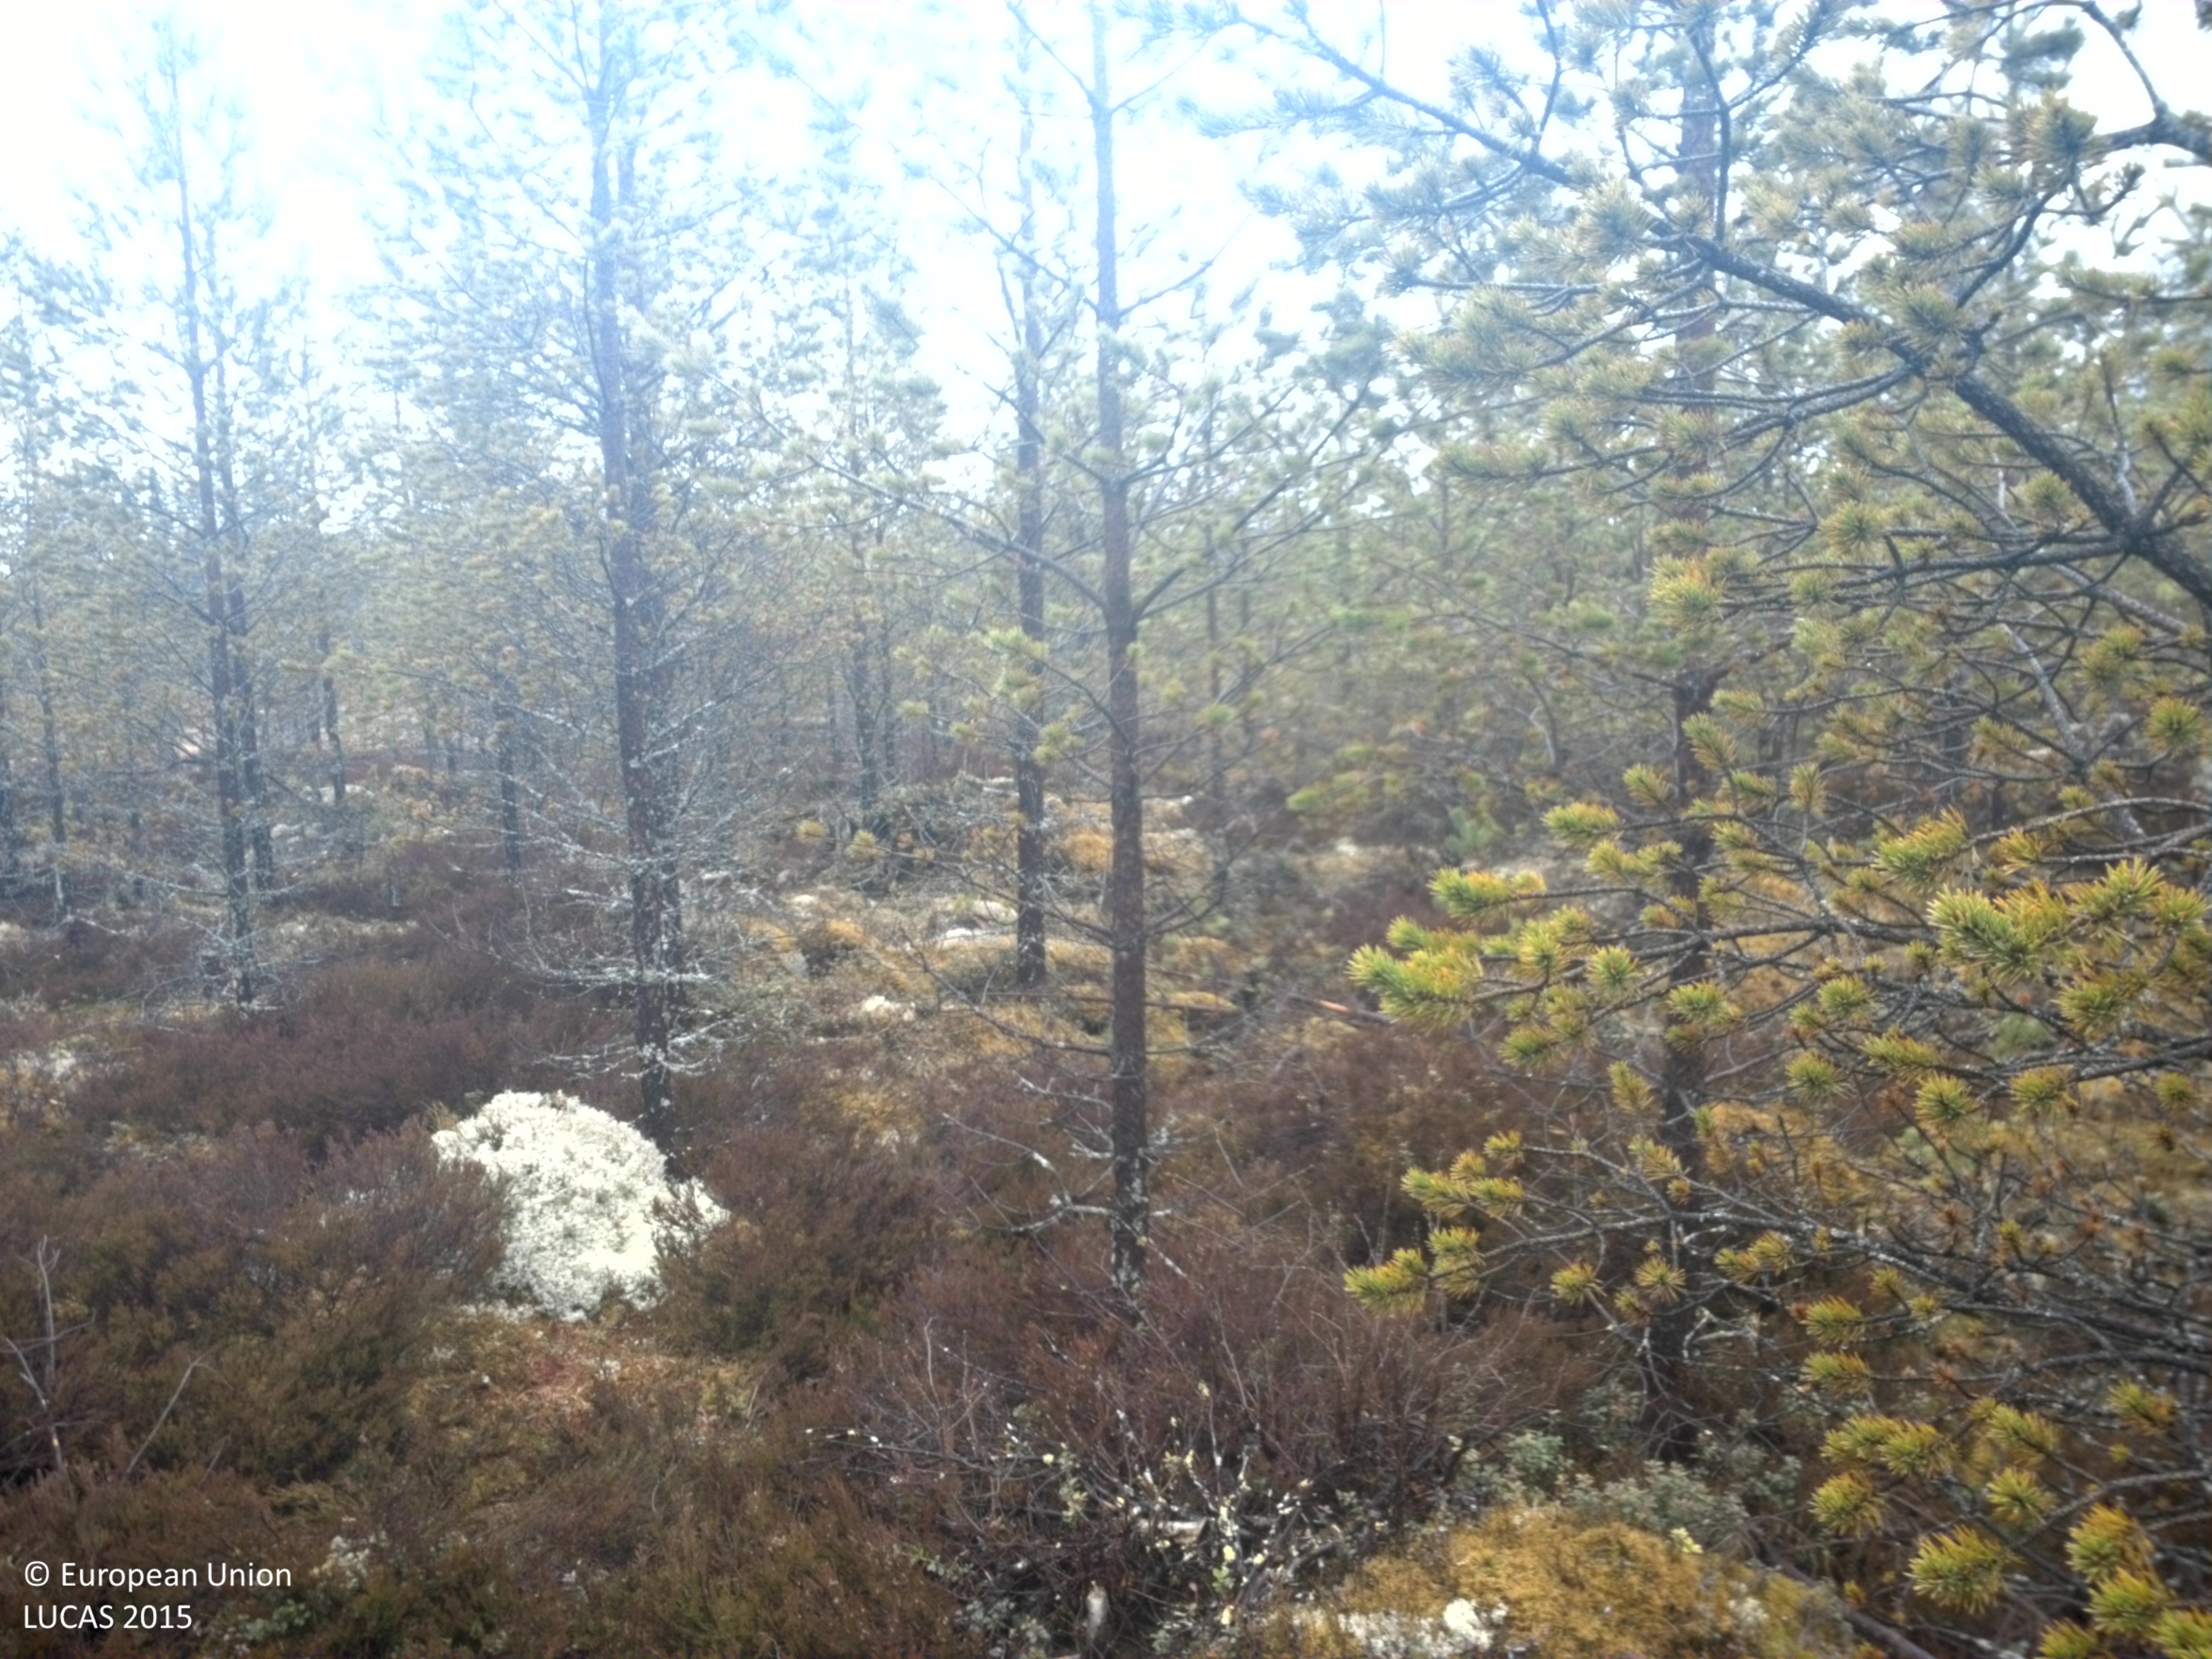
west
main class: Woodland
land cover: Pine dominated coniferous woodland
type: boreal forest
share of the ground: 50 - 75 %
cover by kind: coniferous forest trees 75 %, shrubs 25 %
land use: Forestry
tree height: < 5 m
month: May
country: SE
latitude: 60.9470
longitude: 13.5513
